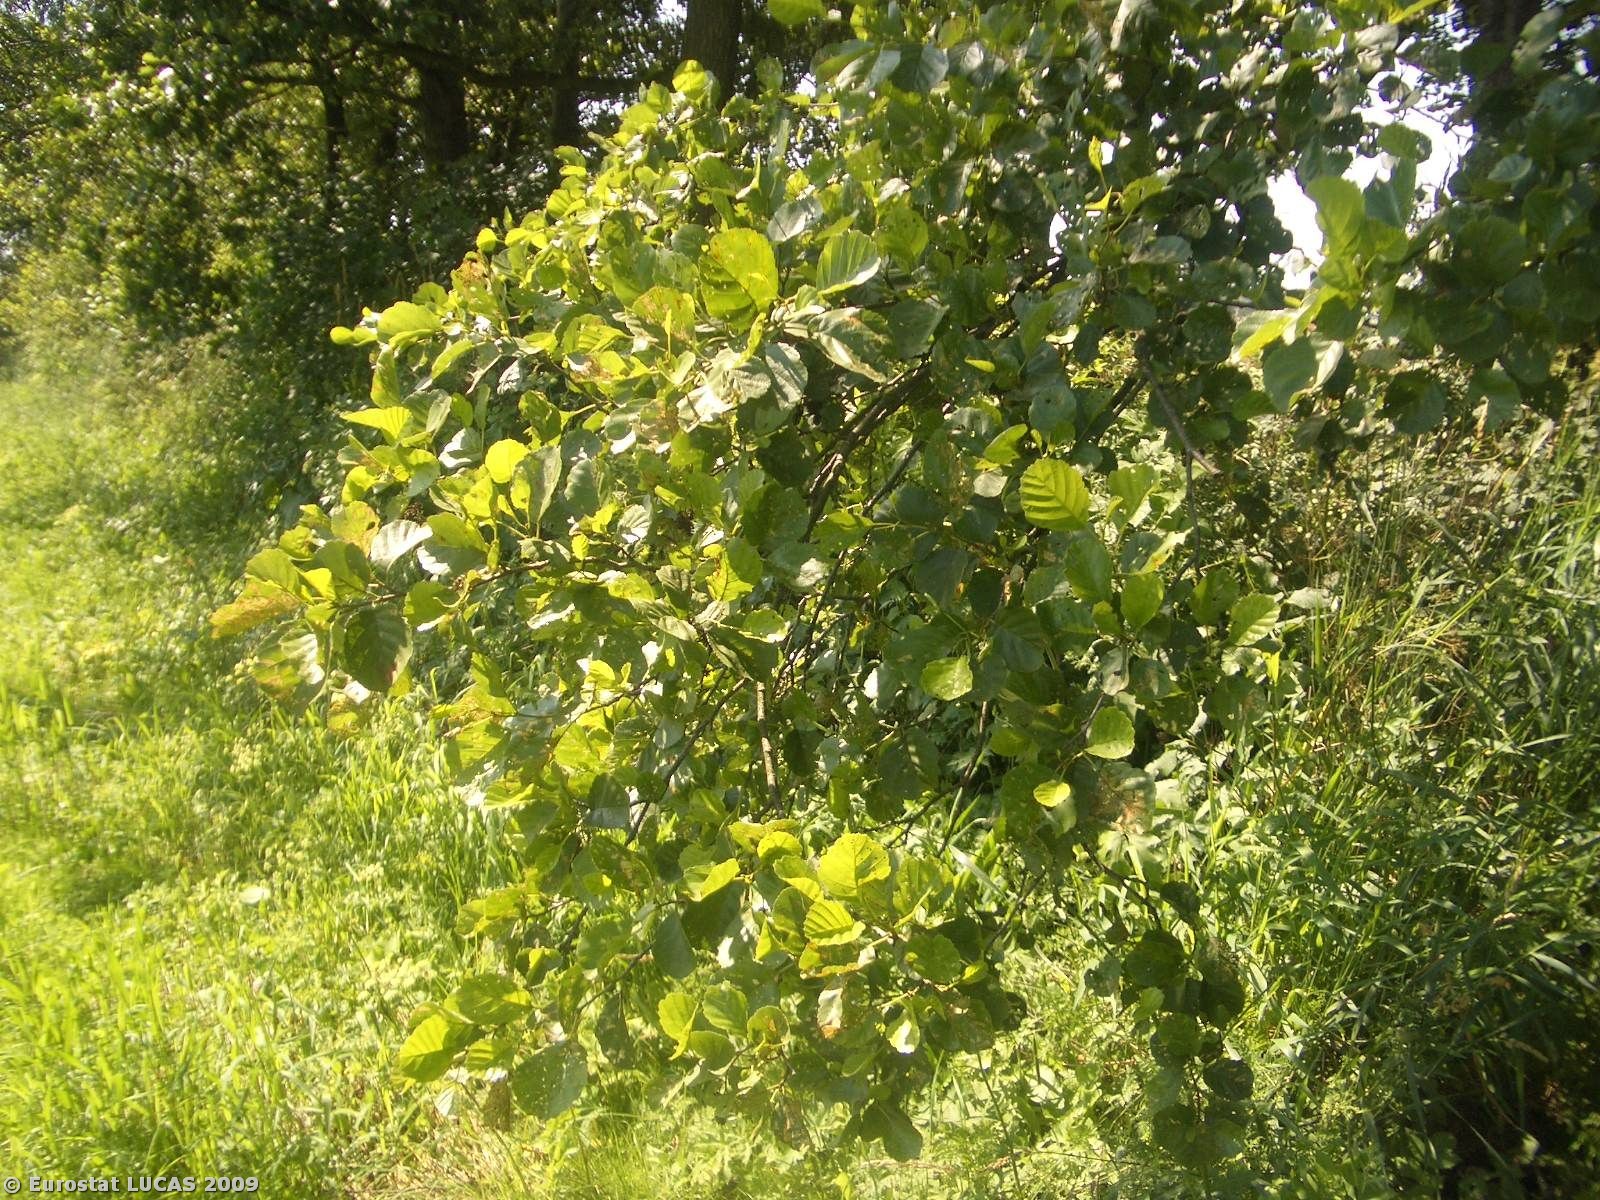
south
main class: Woodland
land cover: Broadleaved woodland
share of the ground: > 75 %
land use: Forestry
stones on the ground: < 10 %
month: July
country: PL
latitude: 52.0669
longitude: 22.5989
